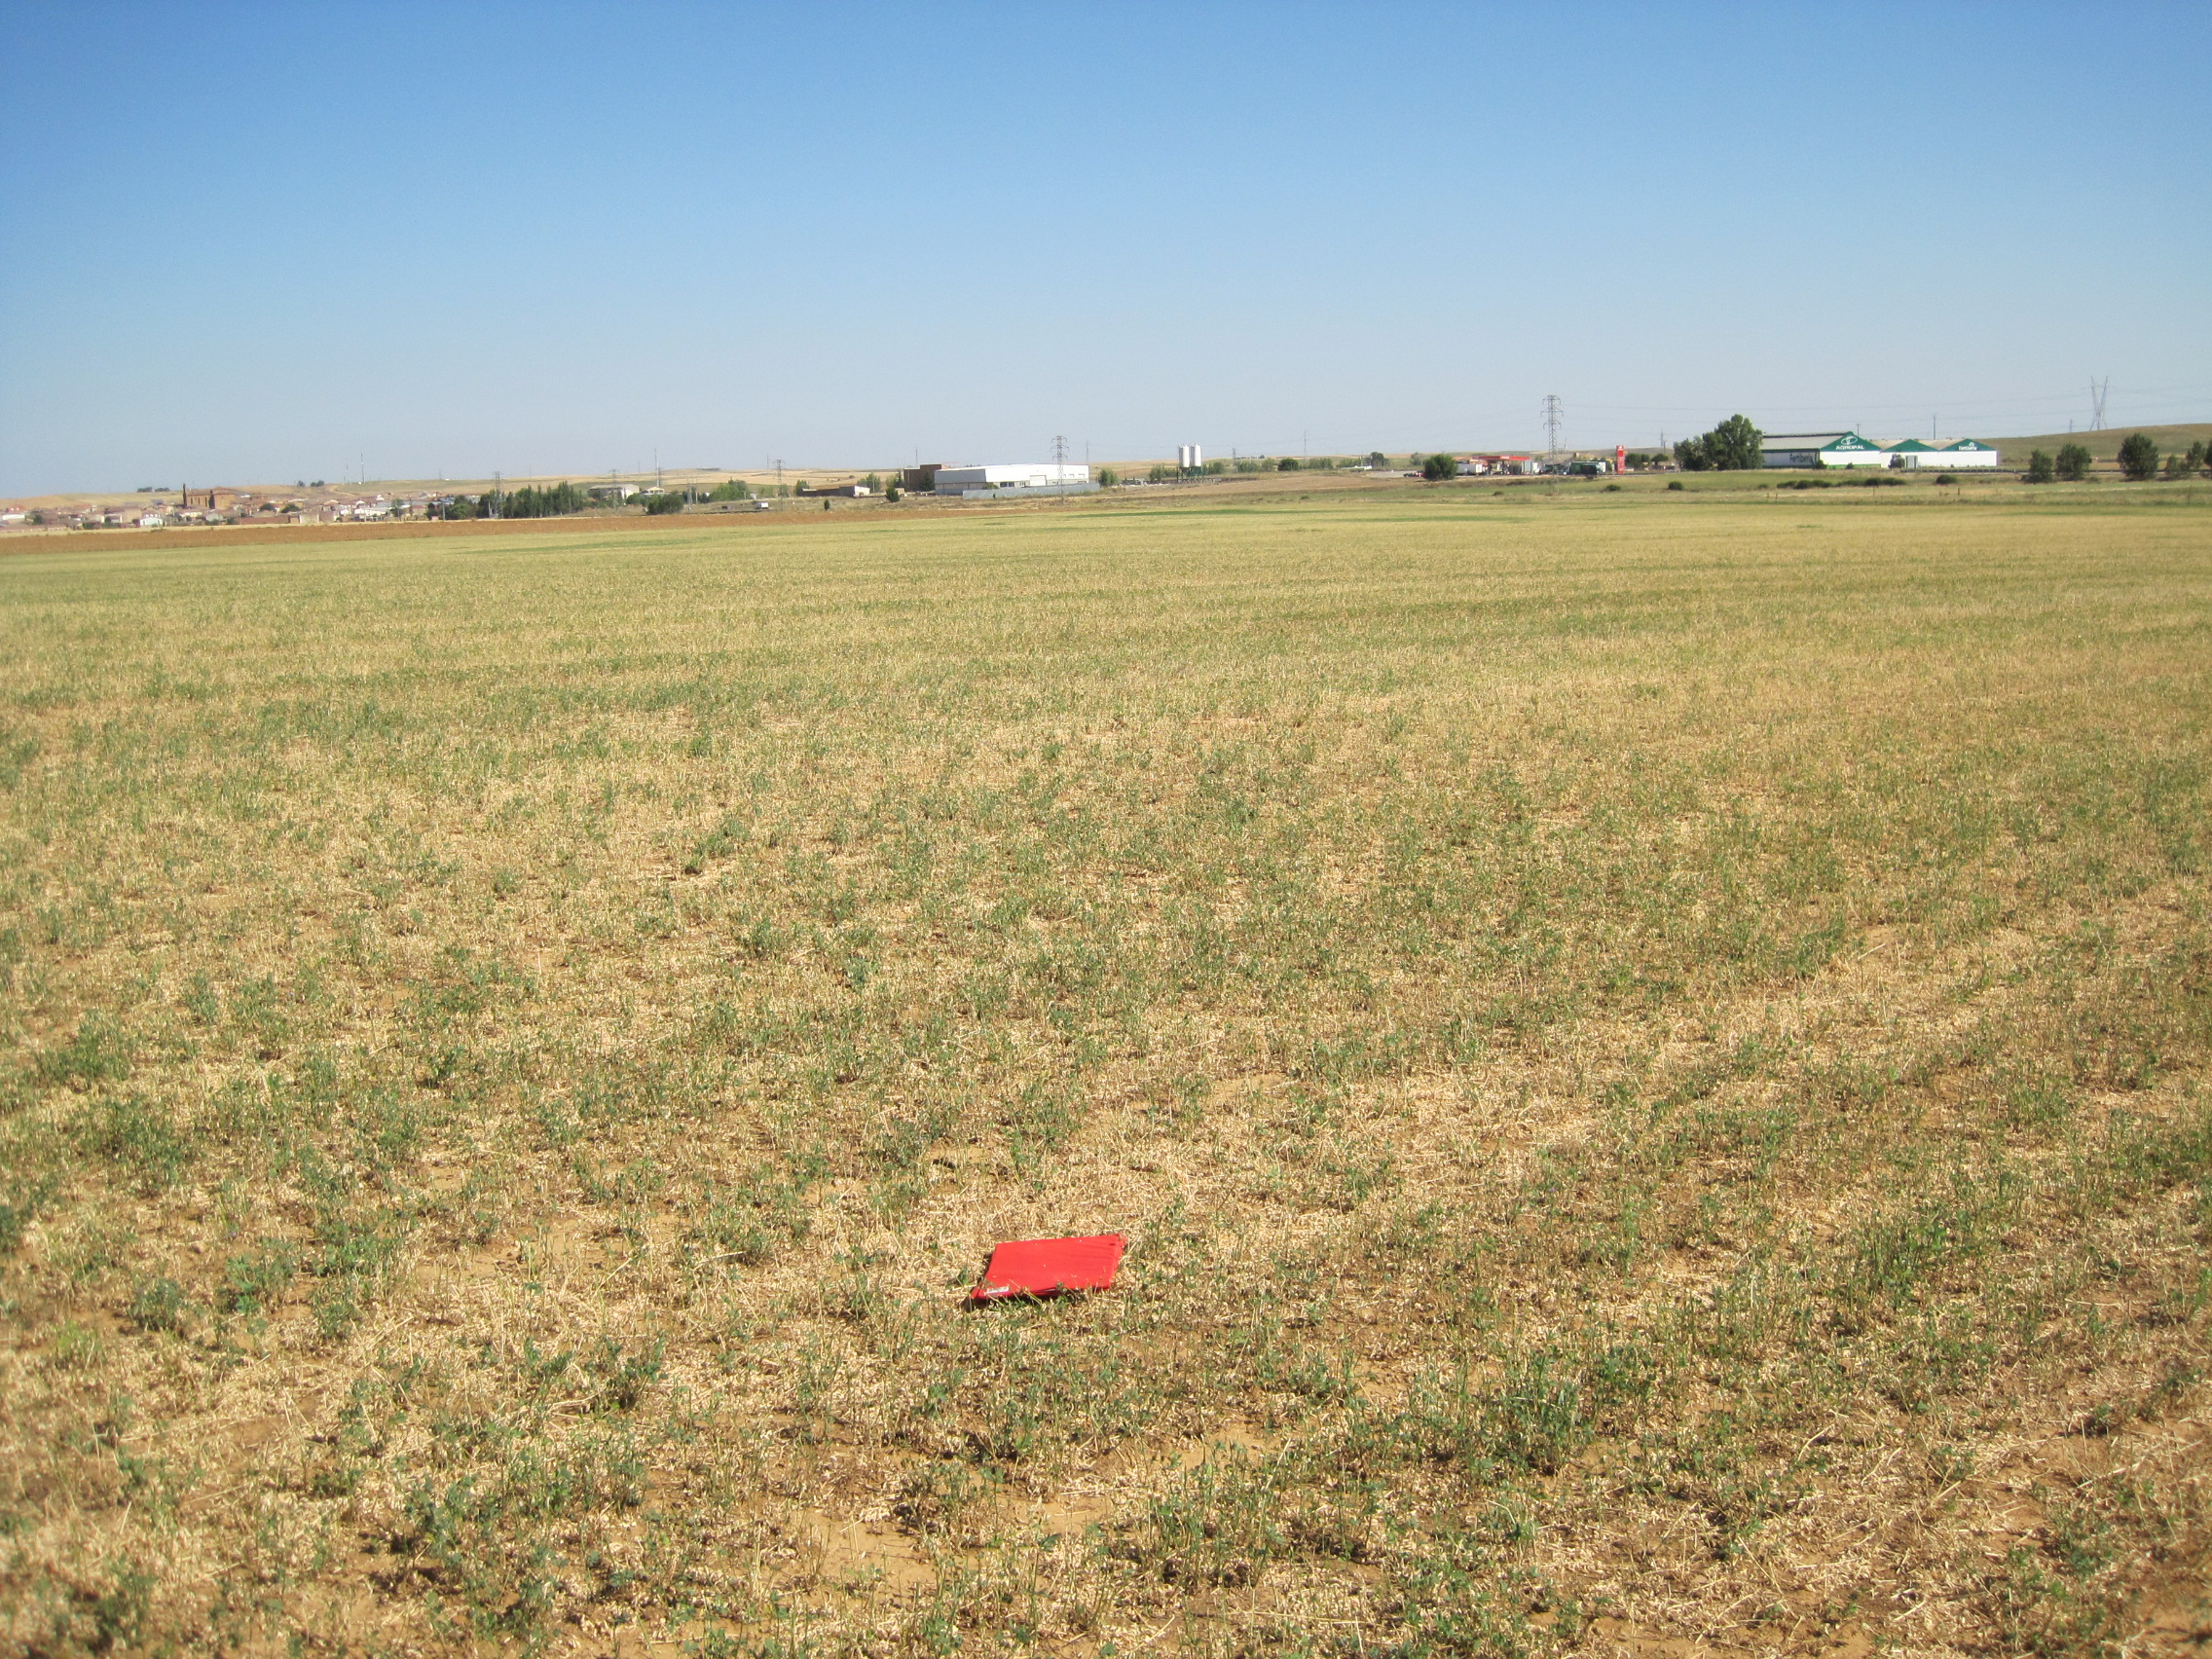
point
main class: Cropland
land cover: Lucerne
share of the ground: 25 - 50 %
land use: Agriculture (excluding fallow land and kitchen gardens)
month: July
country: ES
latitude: 42.0851
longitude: -5.2067
